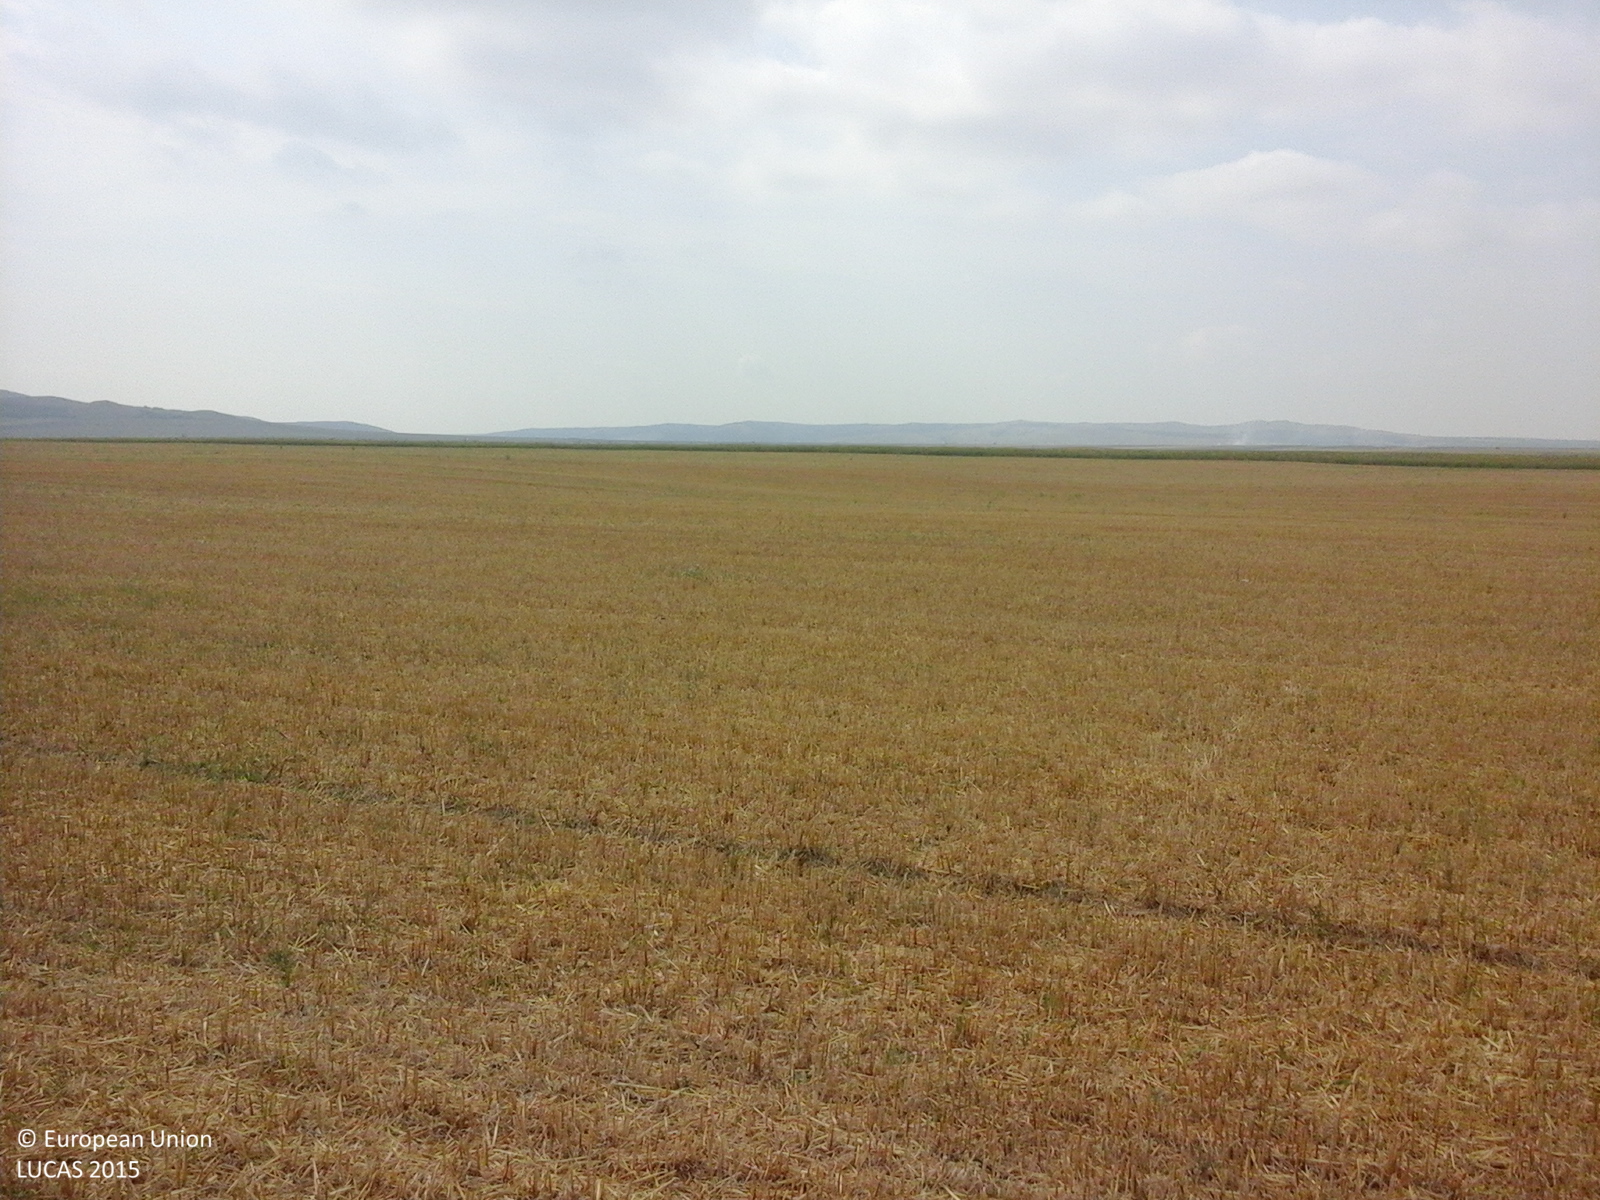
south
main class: Cropland
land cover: Common wheat
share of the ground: > 75 %
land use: Agriculture (excluding fallow land and kitchen gardens)
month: July
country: RO
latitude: 44.9600
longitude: 28.1830
